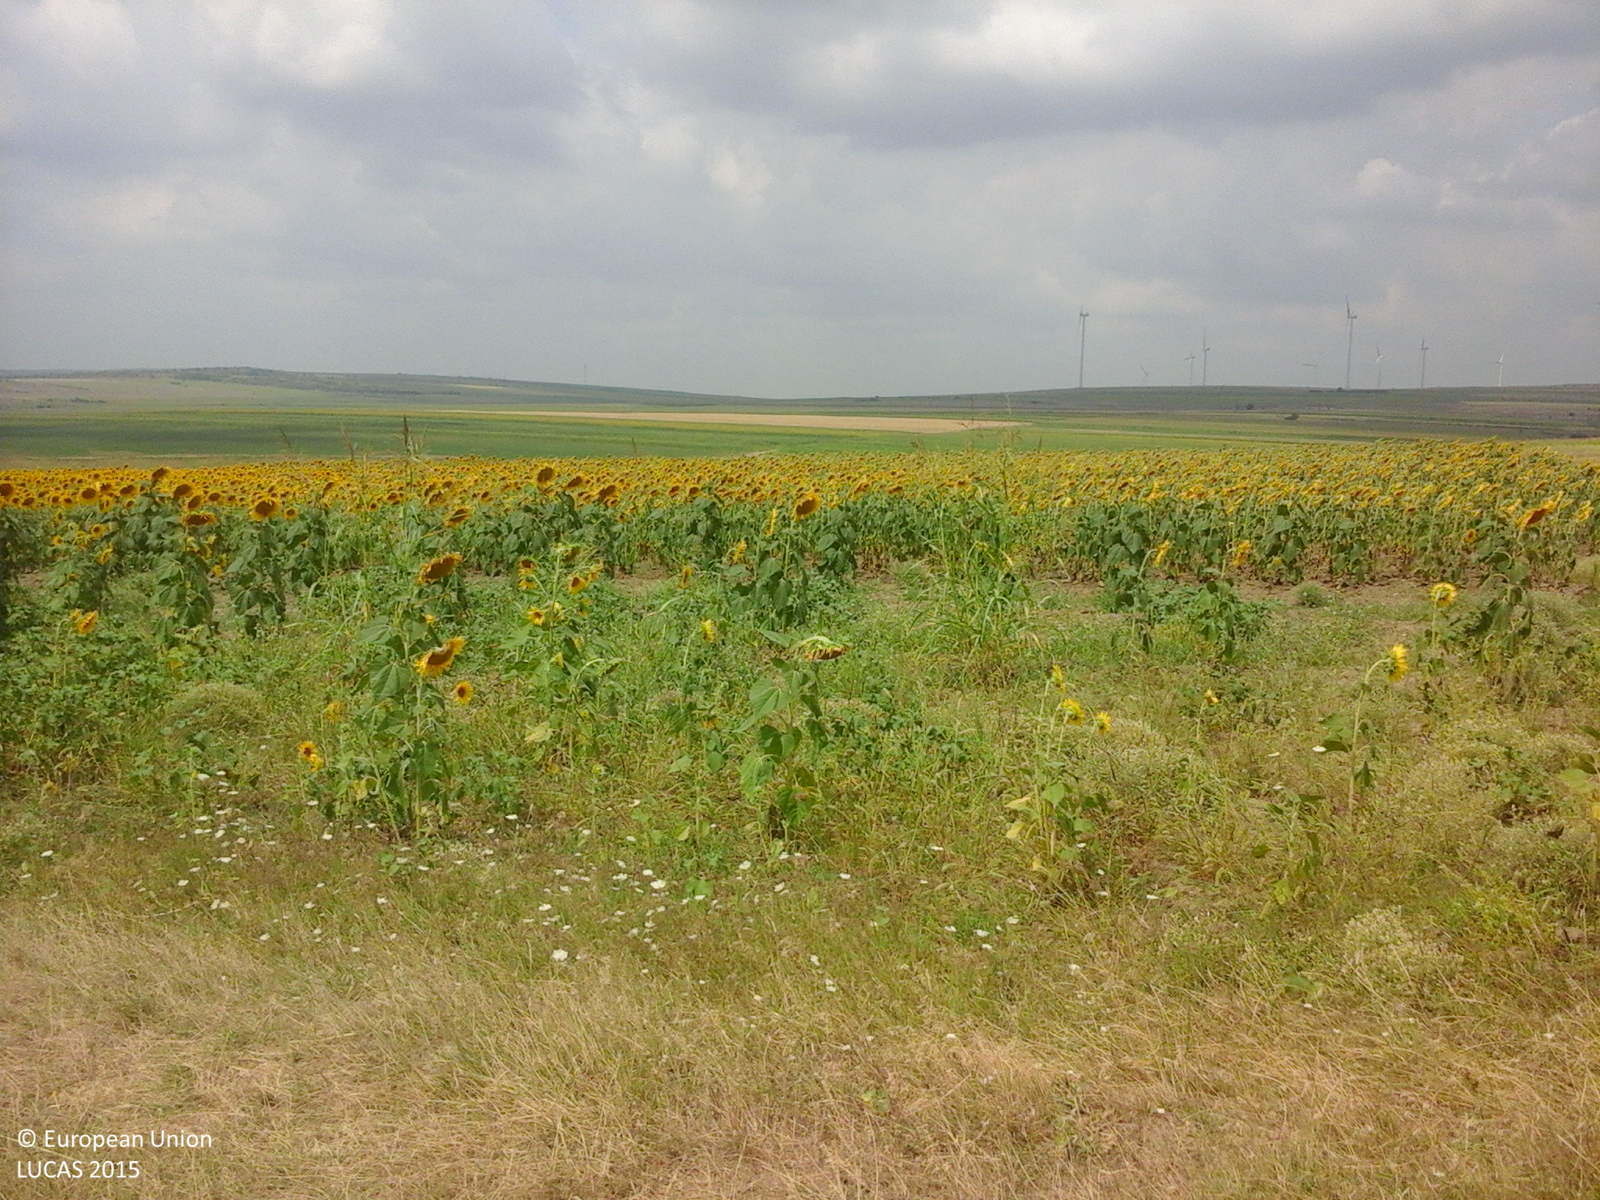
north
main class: Cropland
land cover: Sunflower
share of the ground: > 75 %
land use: Agriculture (excluding fallow land and kitchen gardens)
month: July
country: RO
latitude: 44.8815
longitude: 28.3137
